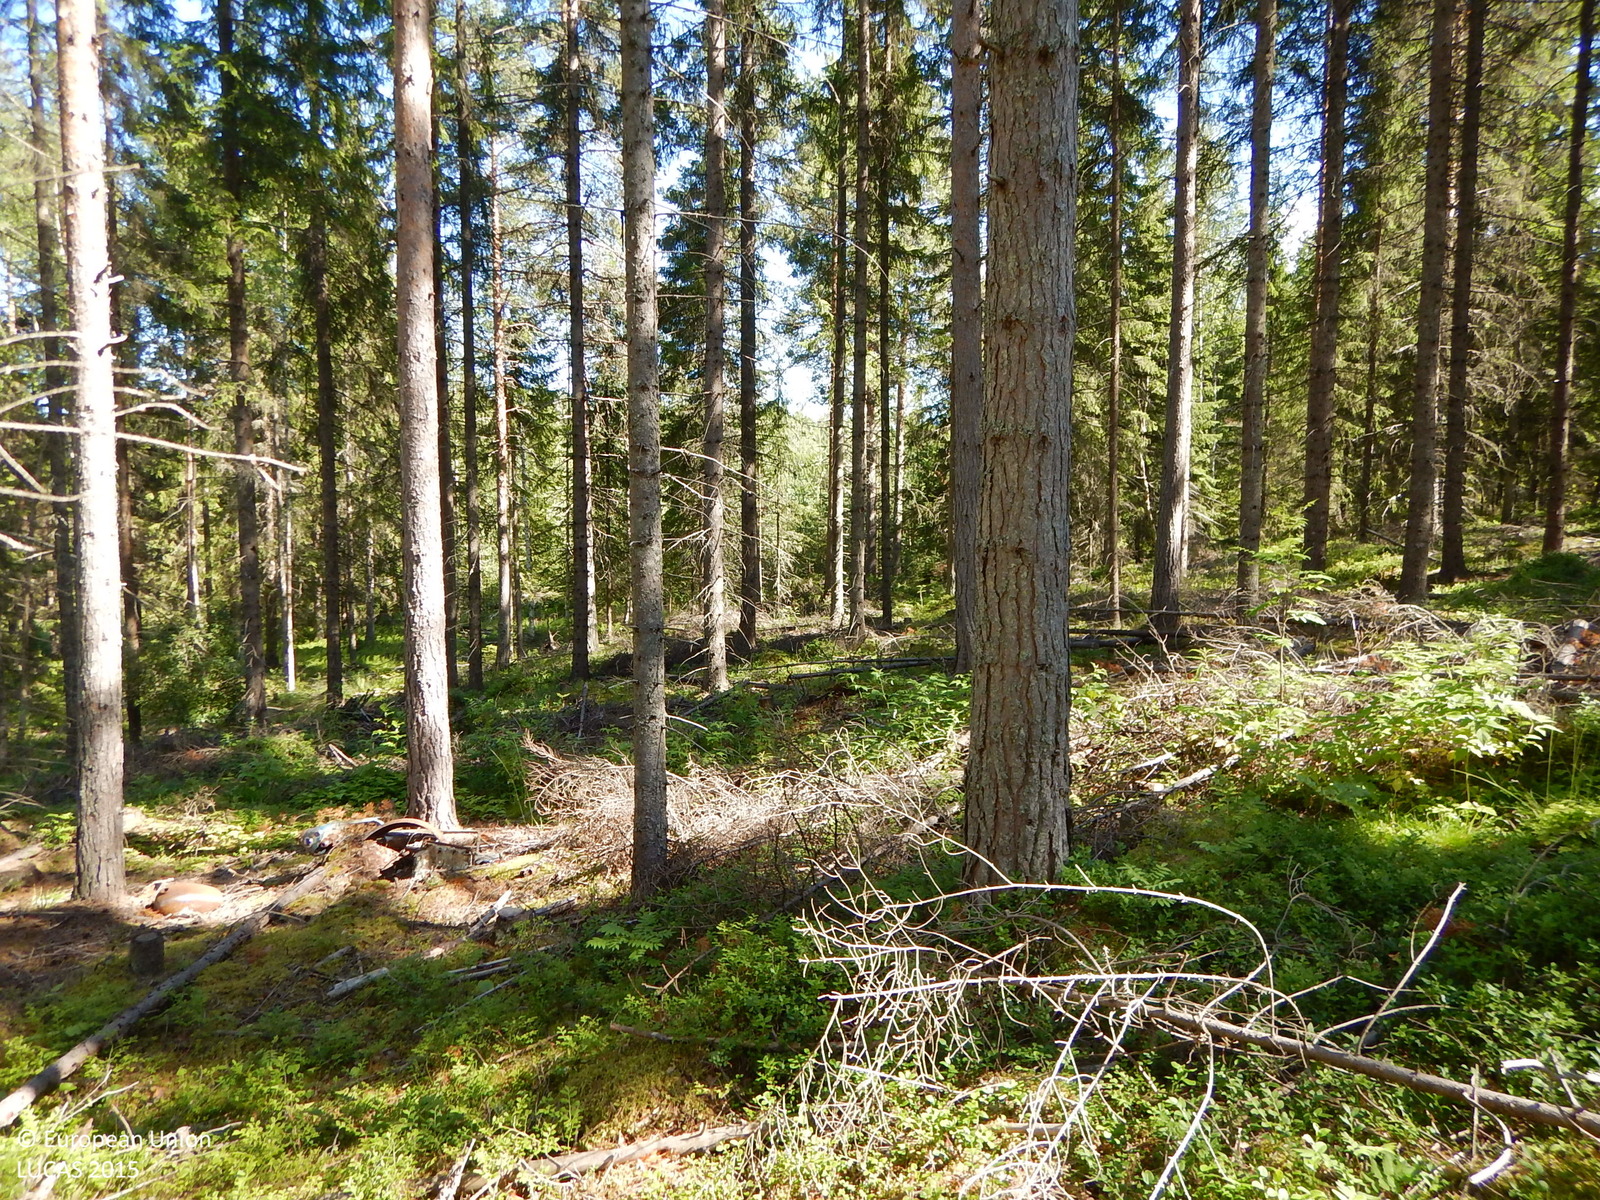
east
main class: Woodland
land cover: Spruce dominated coniferous woodland
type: boreal forest
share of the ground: 50 - 75 %
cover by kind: coniferous forest trees 50 %, shrubs 15 %, herbaceous plants 15 %, broadleaved forest trees 10 %, lichens and mosses 10 %
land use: Forestry
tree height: > 5 m
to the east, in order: Spruce dominated coniferous woodland; Tracks; Spruce dominated mixed woodland; Other mixed woodland; Spruce dominated mixed woodland; Broadleaved woodland; Tracks; Shruby margins; Electric lines; Grass margins; Ditches and canals; Grassland with sparse tree/shrub cover
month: July
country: SE
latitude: 64.8164
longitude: 21.0356
